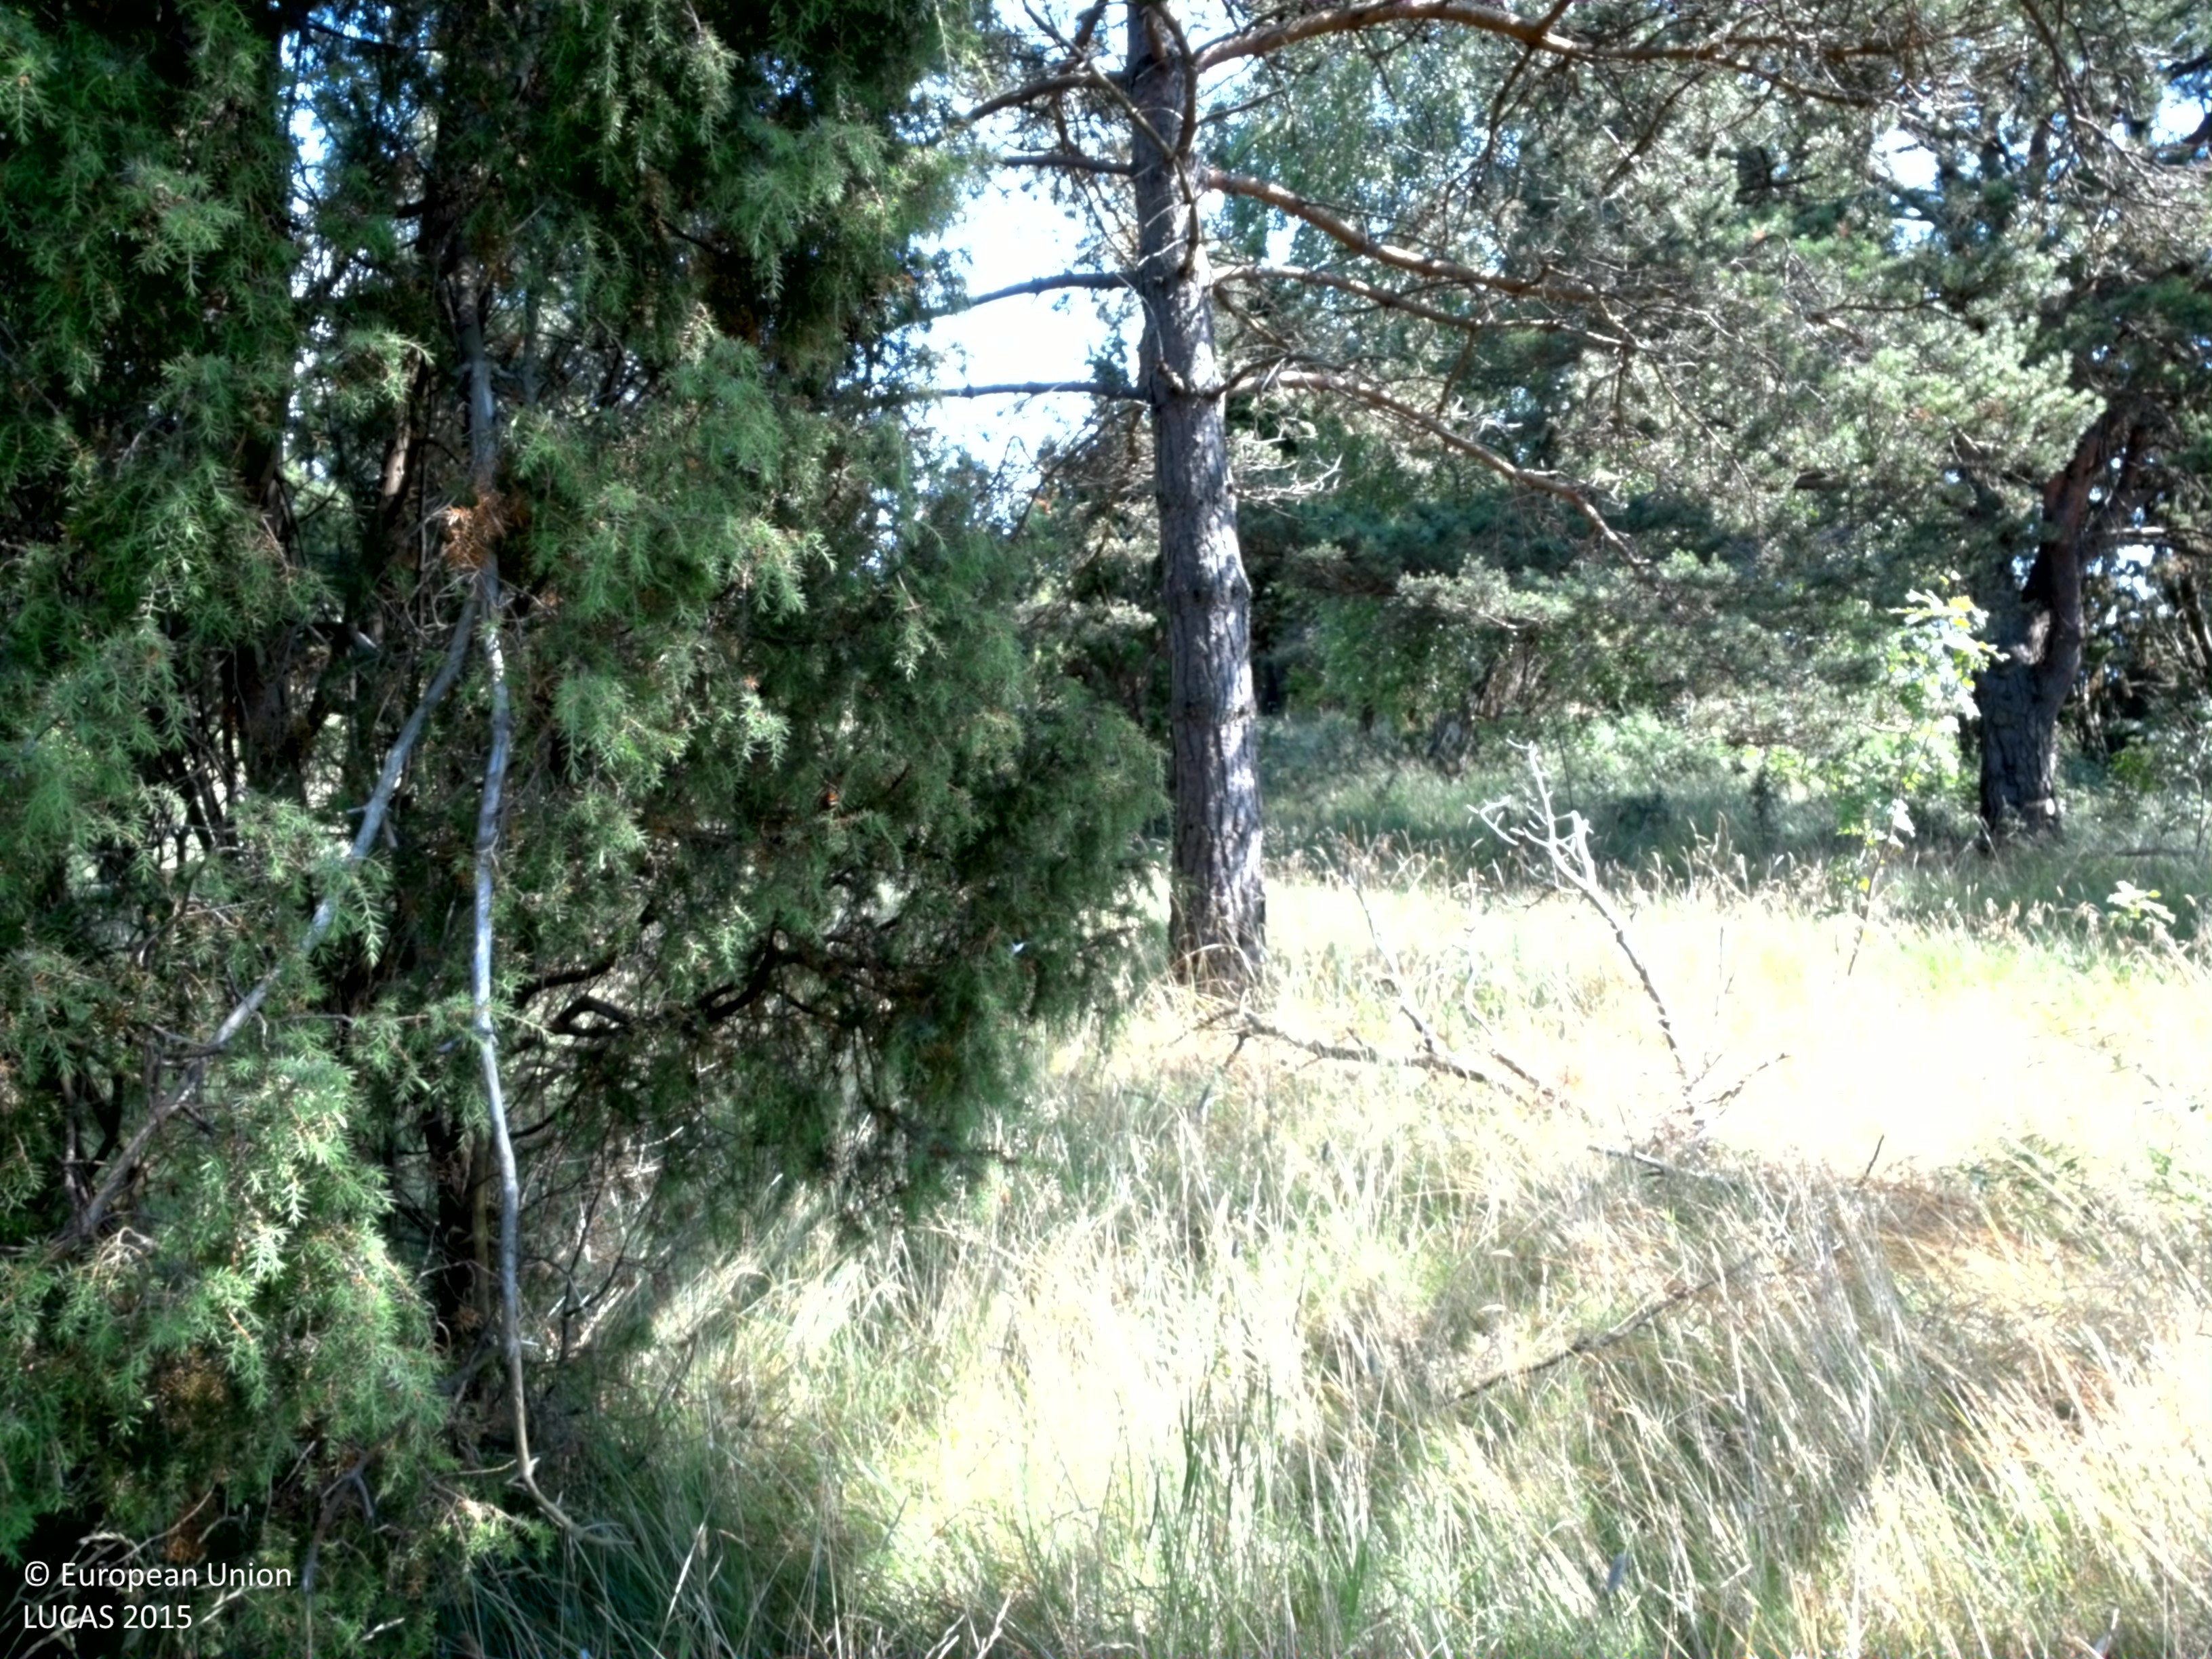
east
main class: Woodland
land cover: Pine dominated coniferous woodland
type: hemiboreal forest and nemoral coniferous forest and mixed broadleaved-coniferous forest
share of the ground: 50 - 75 %
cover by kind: coniferous forest trees 50 %, herbaceous plants 30 %, shrubs 20 %
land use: Amenities, museums, leisure
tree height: > 5 m
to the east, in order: Pine dominated coniferous woodland; Shrubland with sparse tree cover; Grassland without tree/shrub cover; Shrubland with sparse tree cover
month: July
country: SE
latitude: 57.3219
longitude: 18.6958
